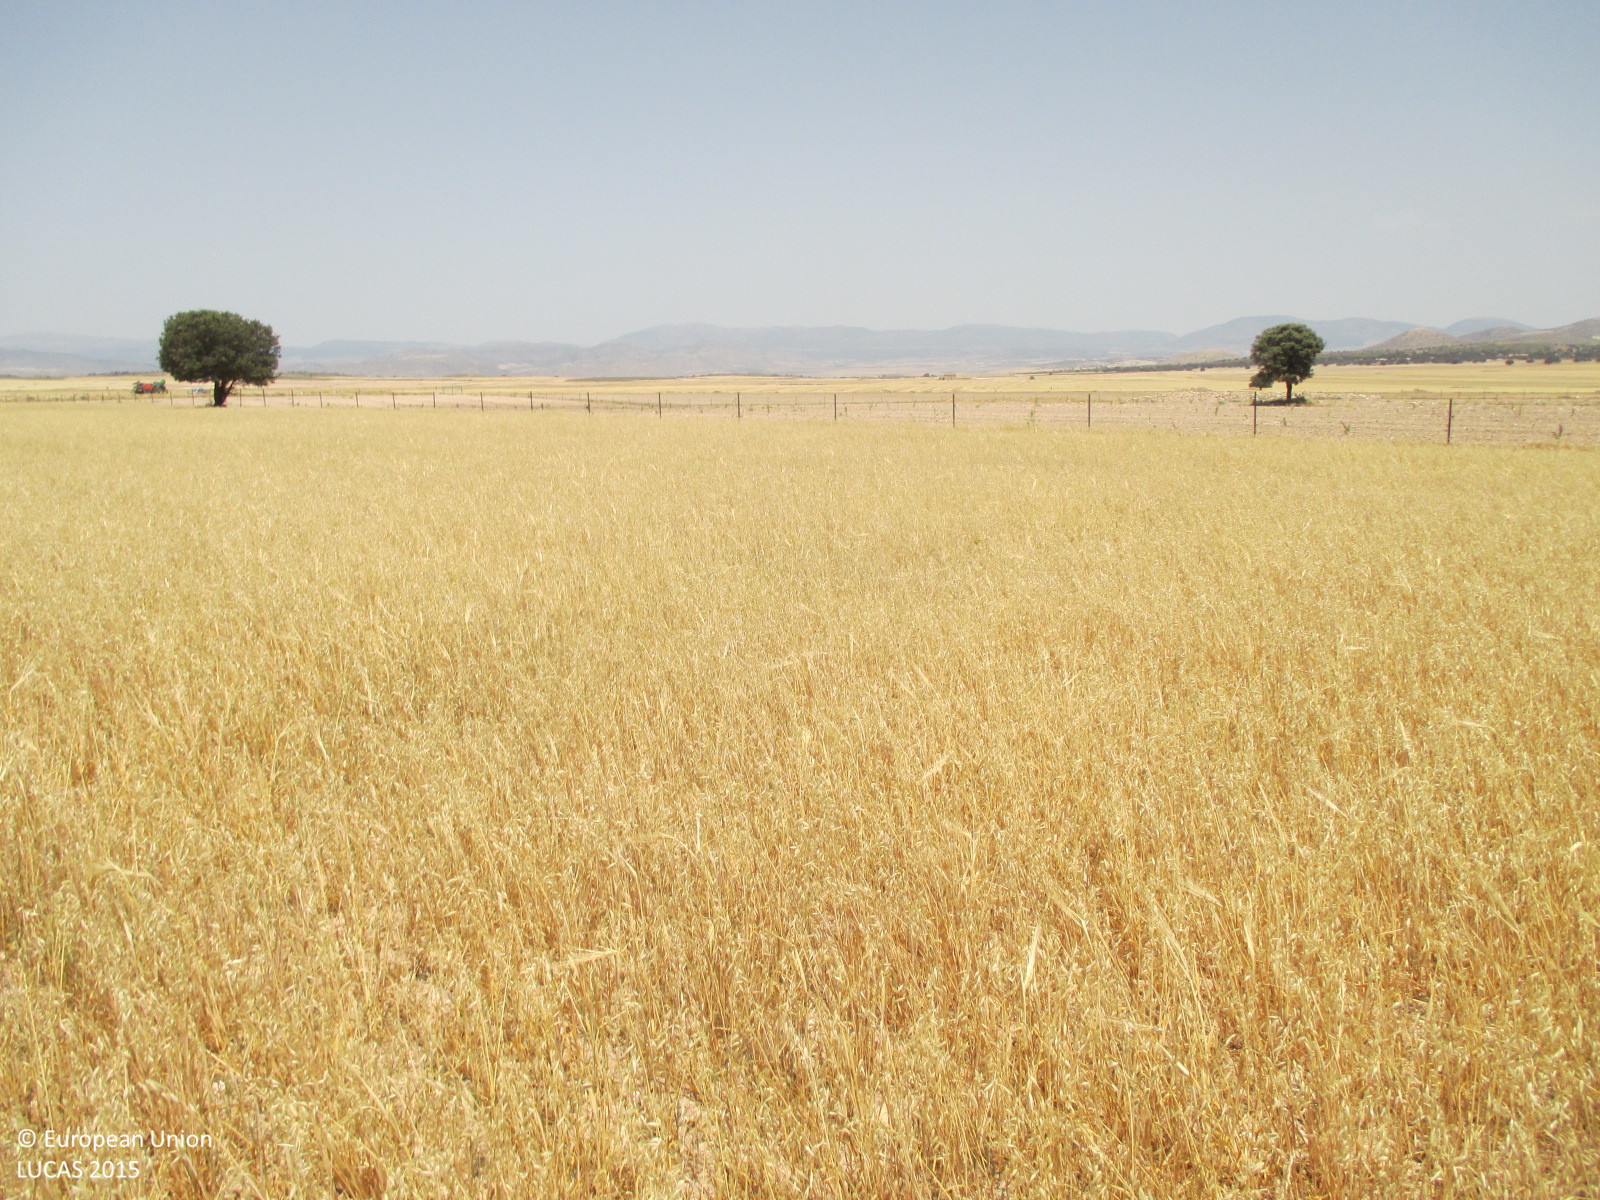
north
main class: Cropland
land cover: Oats
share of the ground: > 75 %
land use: Agriculture (excluding fallow land and kitchen gardens)
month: July
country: ES
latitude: 37.8261
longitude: -2.2925
